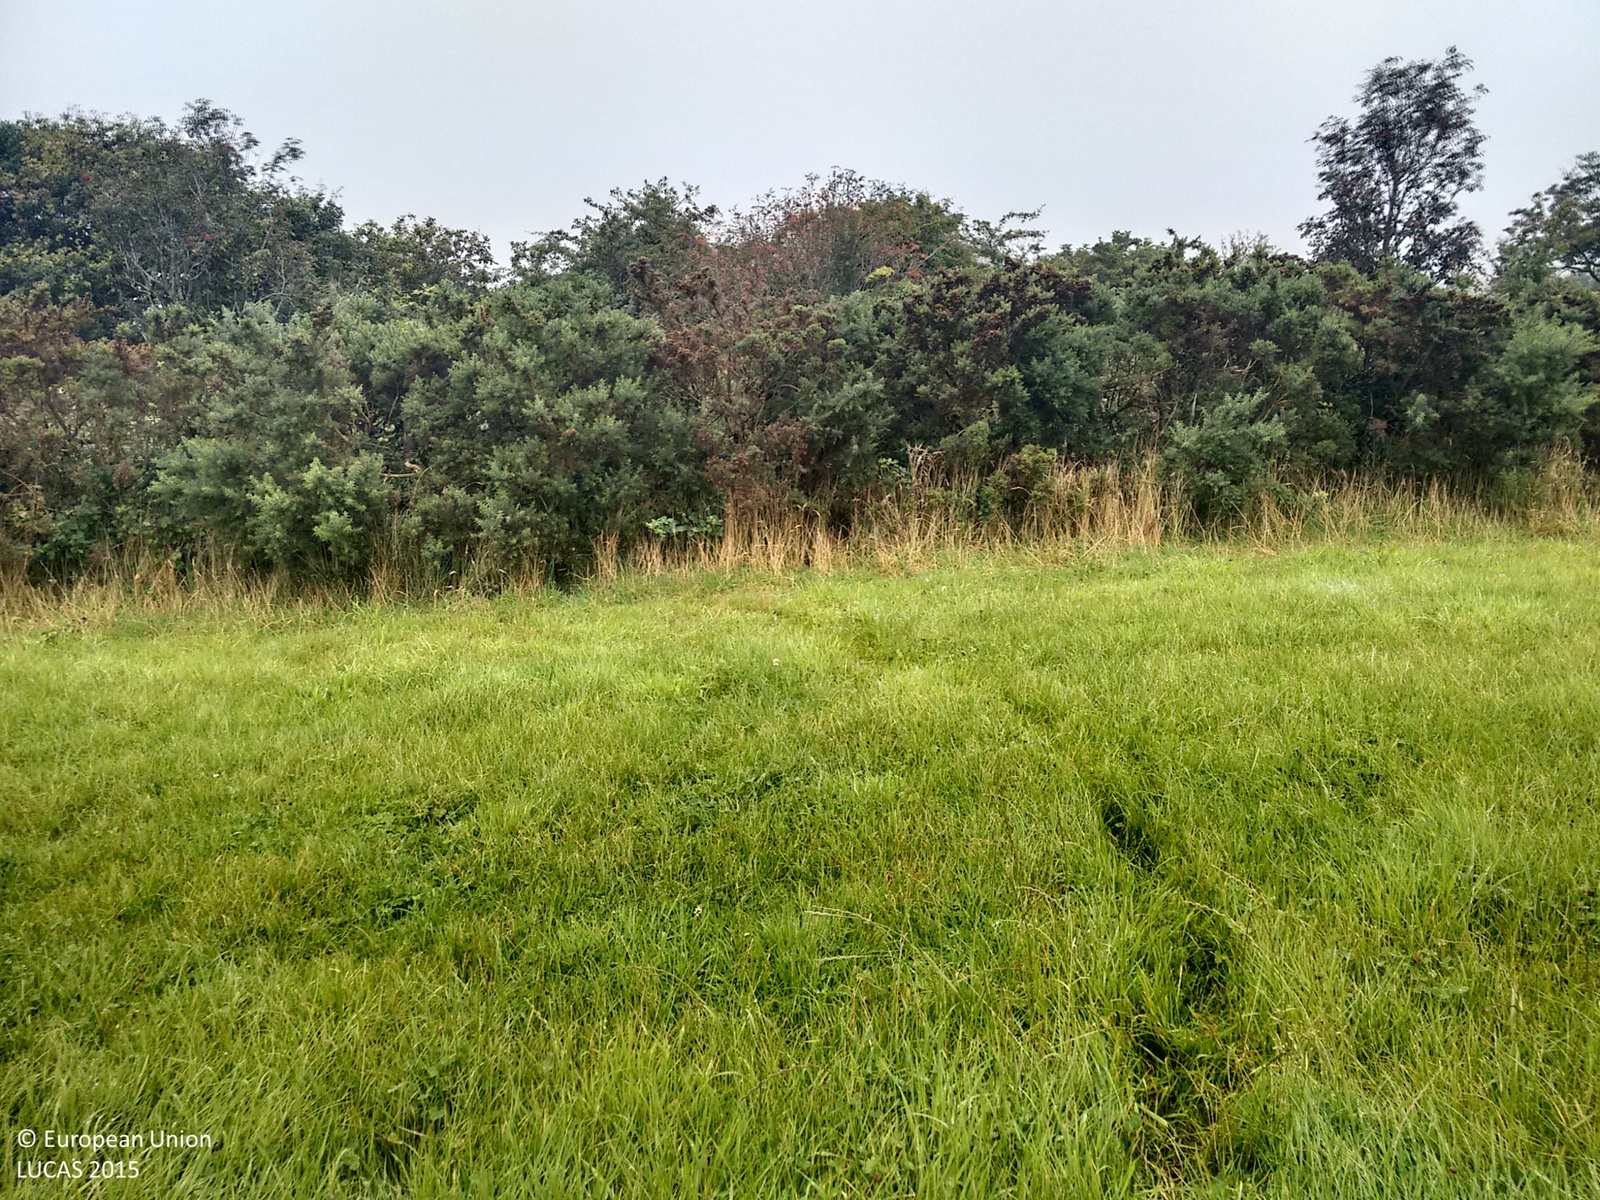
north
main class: Grassland
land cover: Grassland without tree/shrub cover
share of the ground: > 75 %
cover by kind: herbaceous plants 100 %
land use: Agriculture (excluding fallow land and kitchen gardens)
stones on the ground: < 10 %
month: August
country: GB
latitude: 50.5187
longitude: -4.3027
